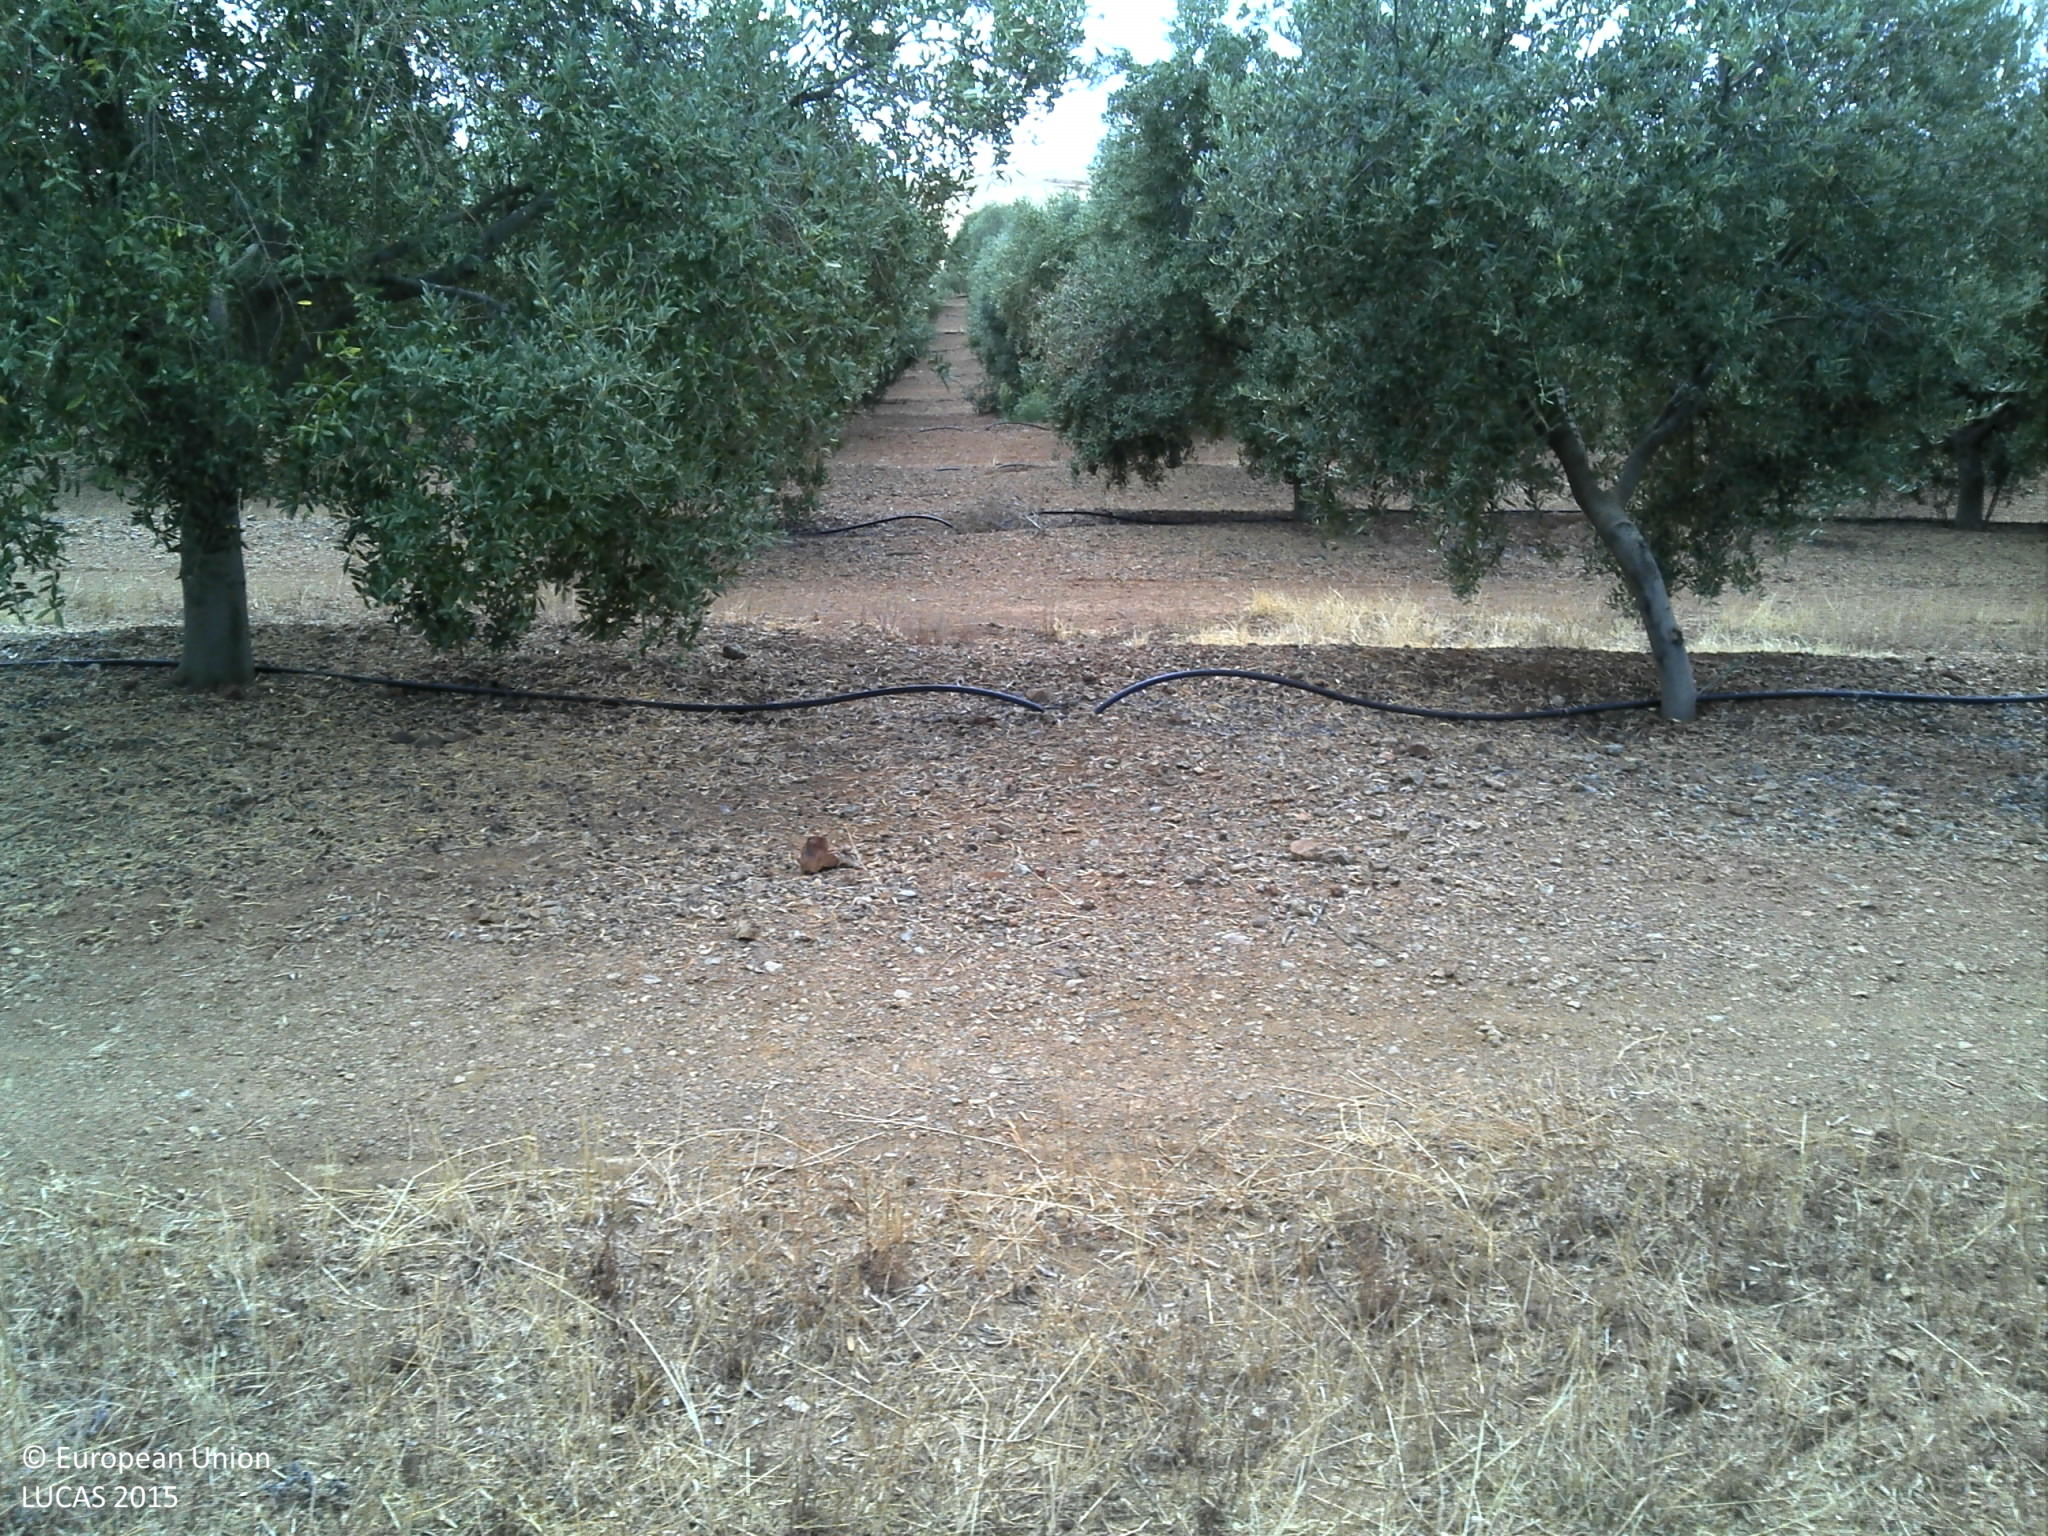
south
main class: Cropland
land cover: Olive groves
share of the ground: 50 - 75 %
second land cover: Grassland without tree/shrub cover
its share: < 10 %
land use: Agriculture (excluding fallow land and kitchen gardens)
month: July
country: PT
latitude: 38.0697
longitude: -7.7046
